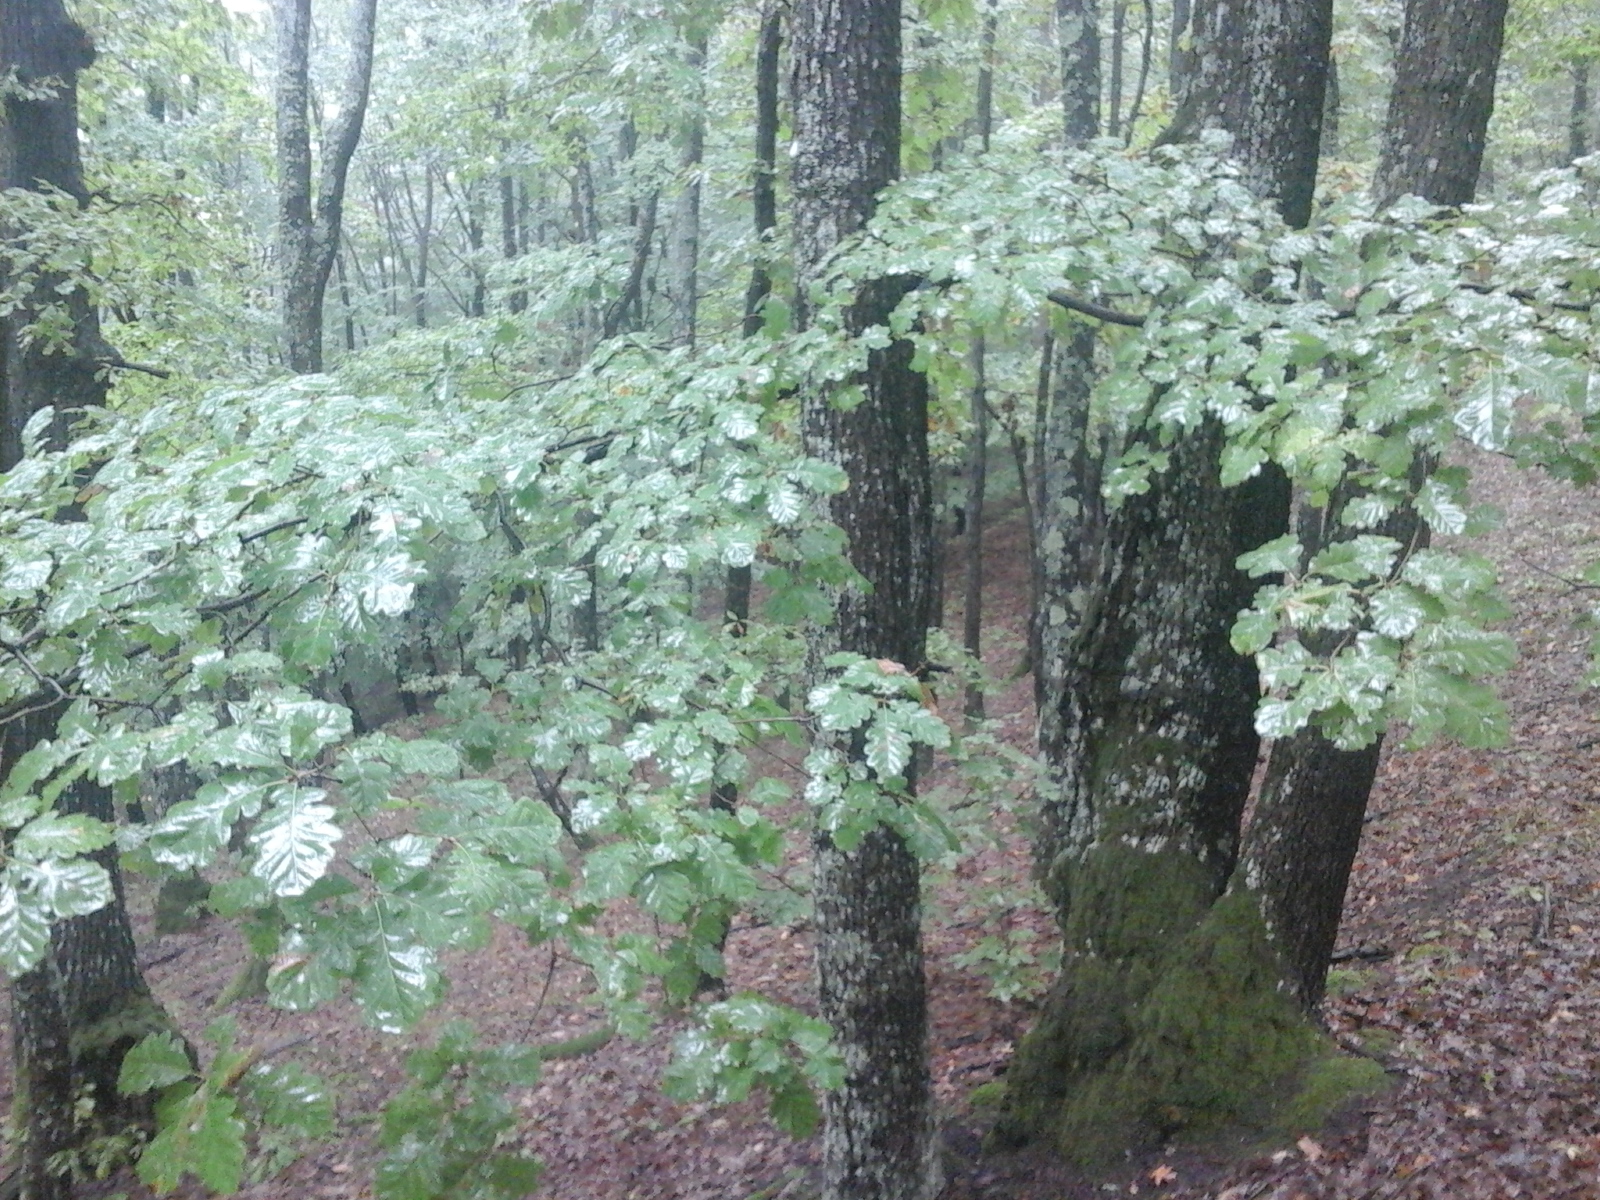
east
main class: Woodland
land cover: Broadleaved woodland
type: acidophilous oak and oak-birch forest
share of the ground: > 75 %
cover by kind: broadleaved forest trees 100 %
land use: Forestry
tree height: > 5 m
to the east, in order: Broadleaved woodland
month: September
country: RO
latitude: 44.9308
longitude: 23.7323
